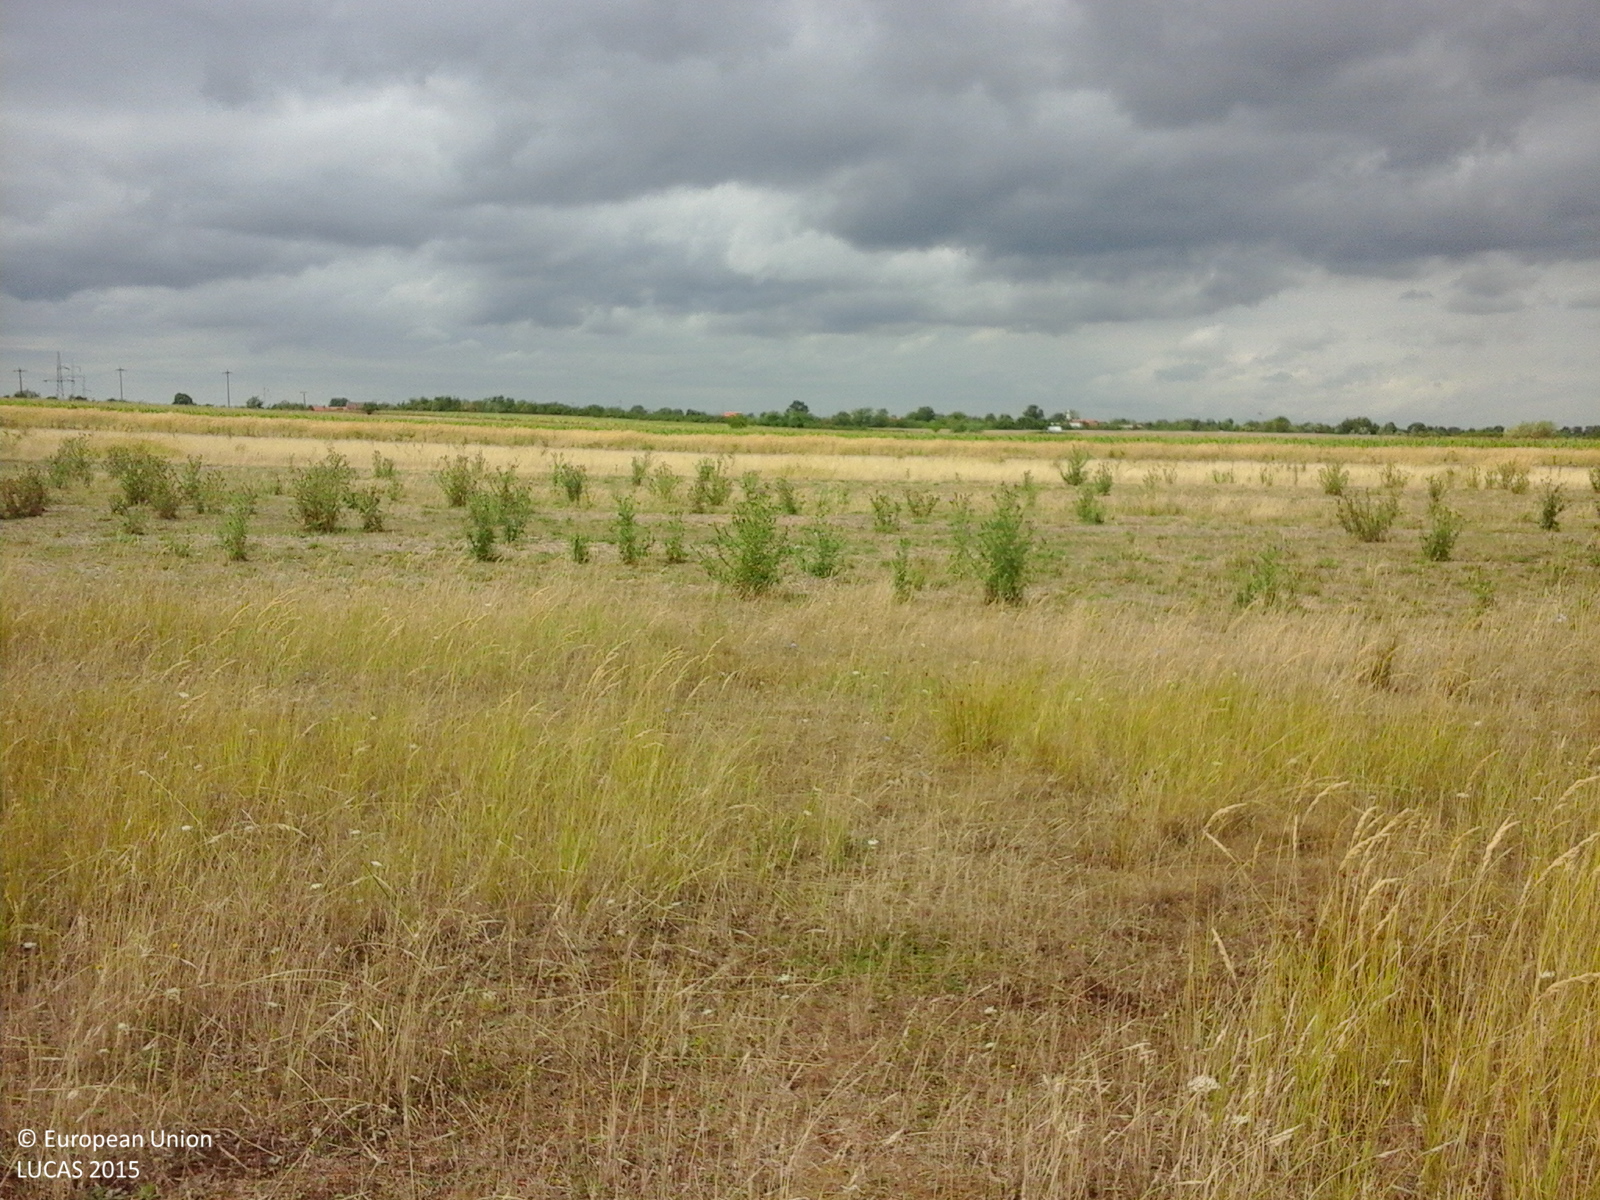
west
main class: Grassland
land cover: Grassland without tree/shrub cover
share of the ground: > 75 %
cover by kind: herbaceous plants 100 %
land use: Agriculture (excluding fallow land and kitchen gardens)
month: August
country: RO
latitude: 45.4267
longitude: 21.5999
